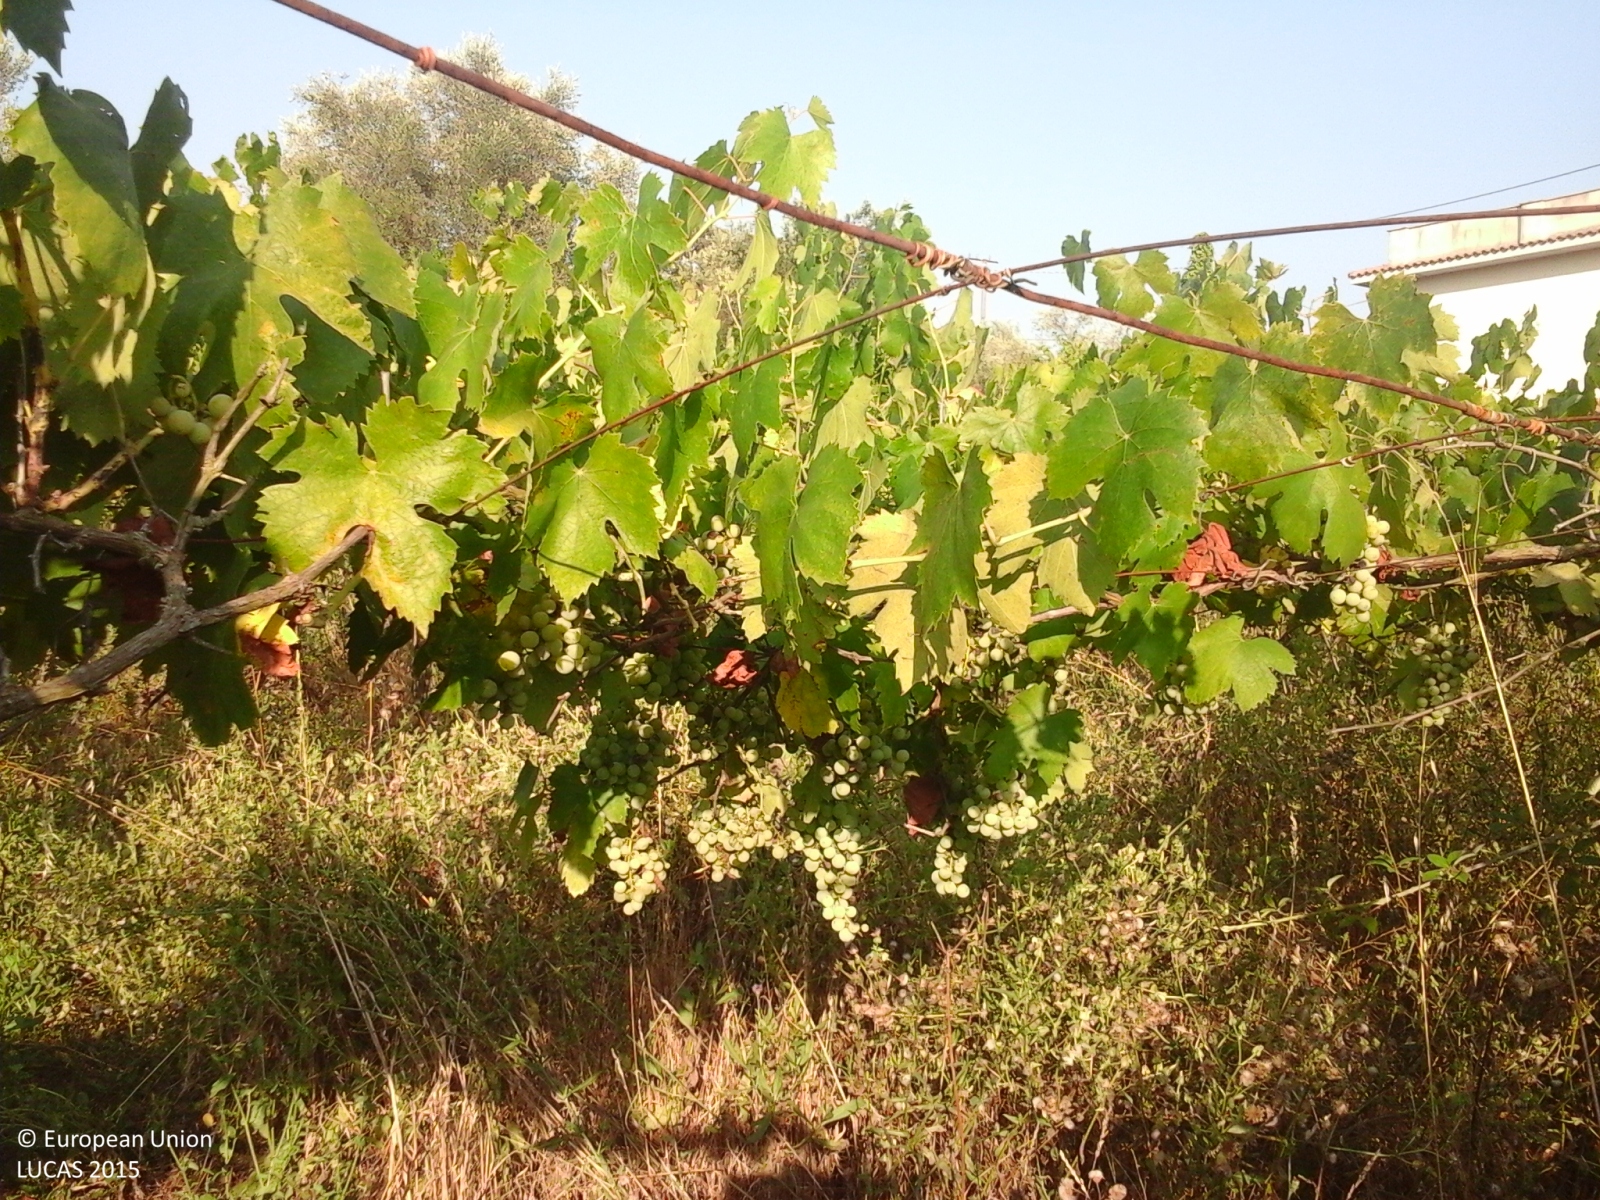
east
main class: Cropland
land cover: Vineyards
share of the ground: 50 - 75 %
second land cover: Grassland without tree/shrub cover
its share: > 75 %
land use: Agriculture (excluding fallow land and kitchen gardens)
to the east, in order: Vineyards; Grassland without tree/shrub cover; Olive groves; Paved roads, cycling and walking lanes; Grass margins; Ditches and canals; Fences; Electric lines; Olive groves; Electric lines; Fences; Managed hedges; Broadleaved woodland; Shrubland without tree cover; Artificial constructions in urban areas; Grassland without tree/shrub cover; Fences; Grassland without tree/shrub cover; Artificial constructions; Fences; Grassland without tree/shrub cover
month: July
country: IT
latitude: 41.6575
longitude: 12.7872
